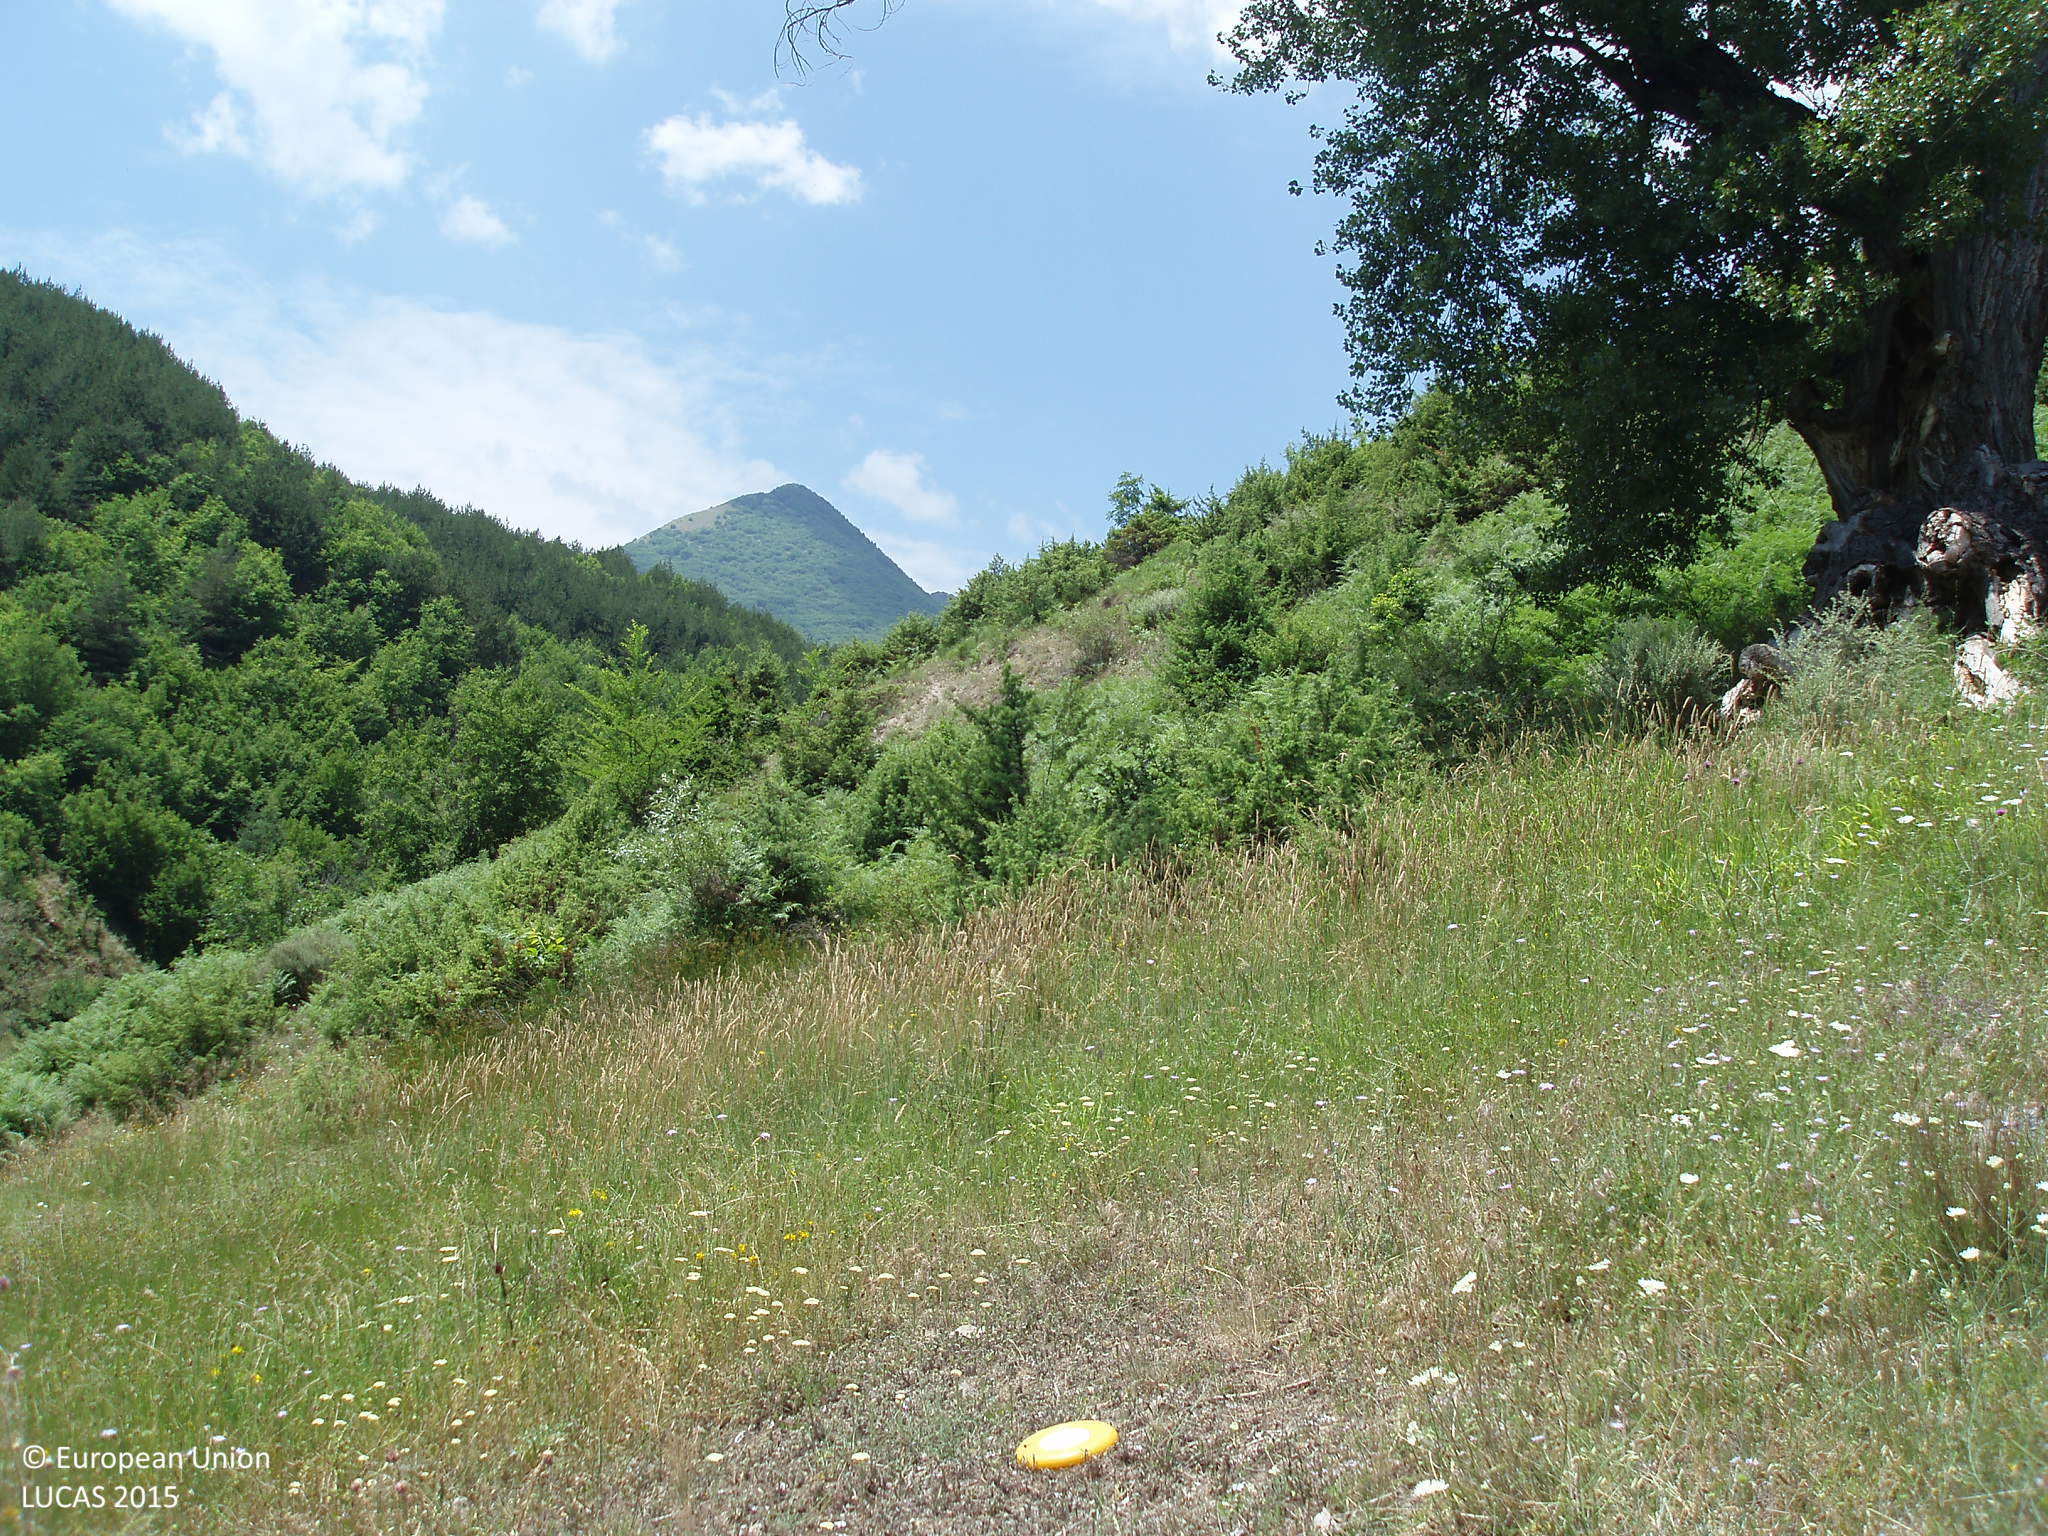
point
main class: Grassland
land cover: Grassland with sparse tree/shrub cover
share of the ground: > 75 %
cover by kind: herbaceous plants 90 %, broadleaved forest trees 5 %, shrubs 5 %
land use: Agriculture (excluding fallow land and kitchen gardens)
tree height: > 5 m
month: June
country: BG
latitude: 41.5913
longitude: 23.6917
